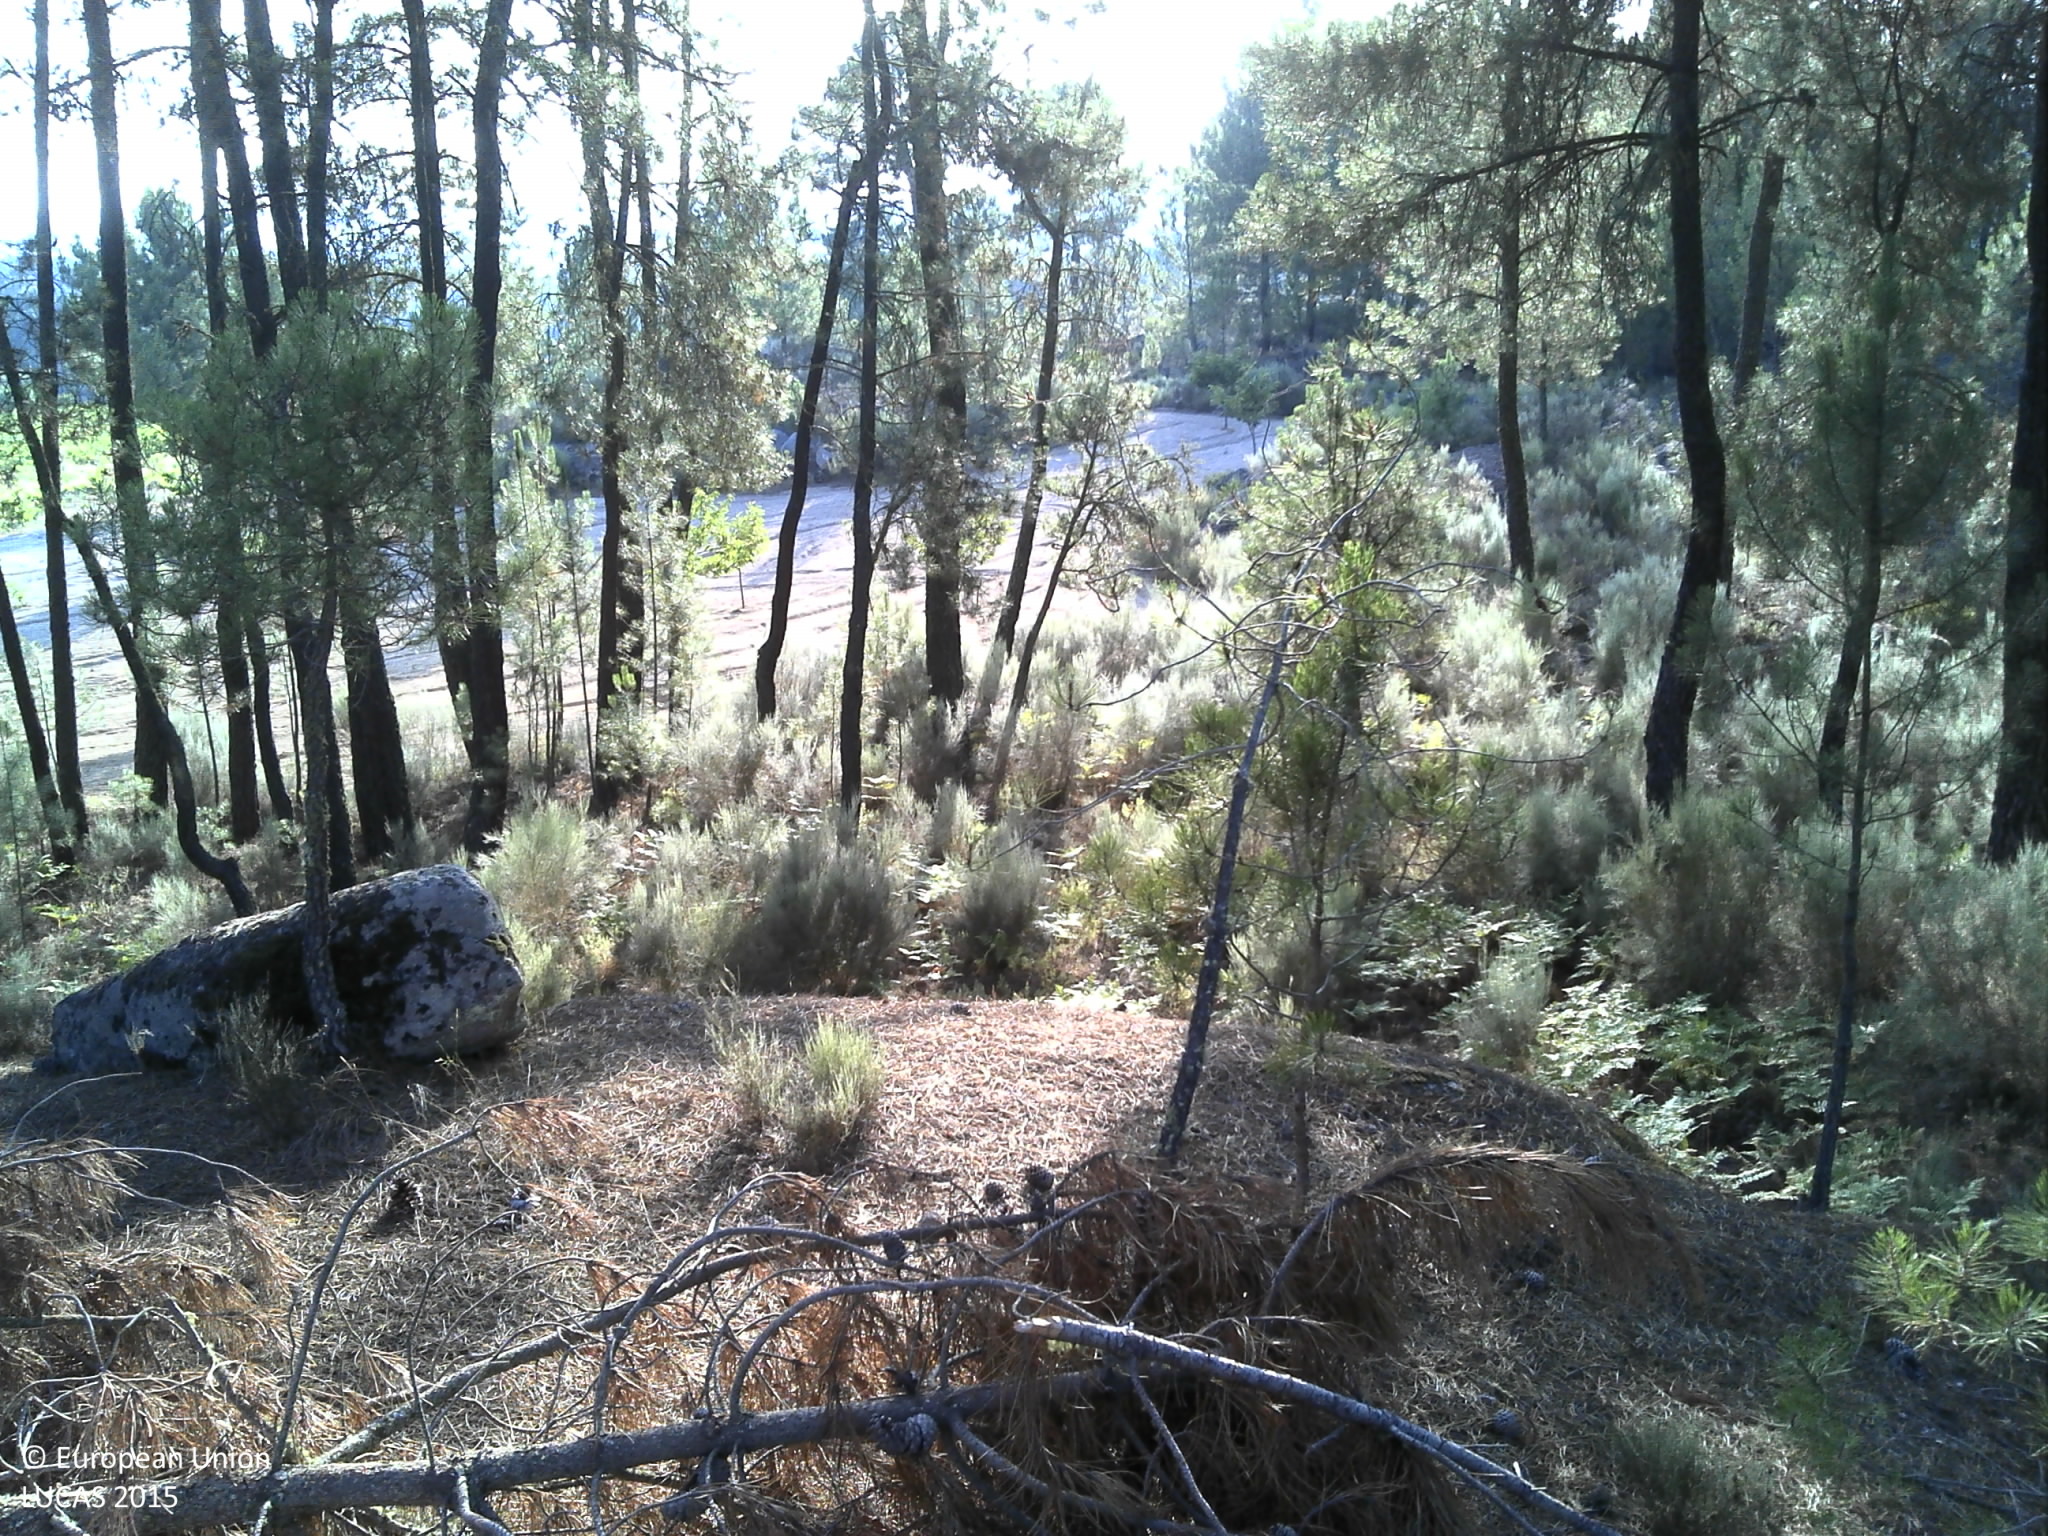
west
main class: Woodland
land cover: Pine dominated coniferous woodland
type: coniferous forest of the mediterranean region
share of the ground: 25 - 50 %
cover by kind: coniferous forest trees 30 %, shrubs 30 %, unconsolidated bare surface 30 %, consolidated bare surface 10 %
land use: Forestry
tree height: > 5 m
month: July
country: PT
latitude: 40.9332
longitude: -7.4933
